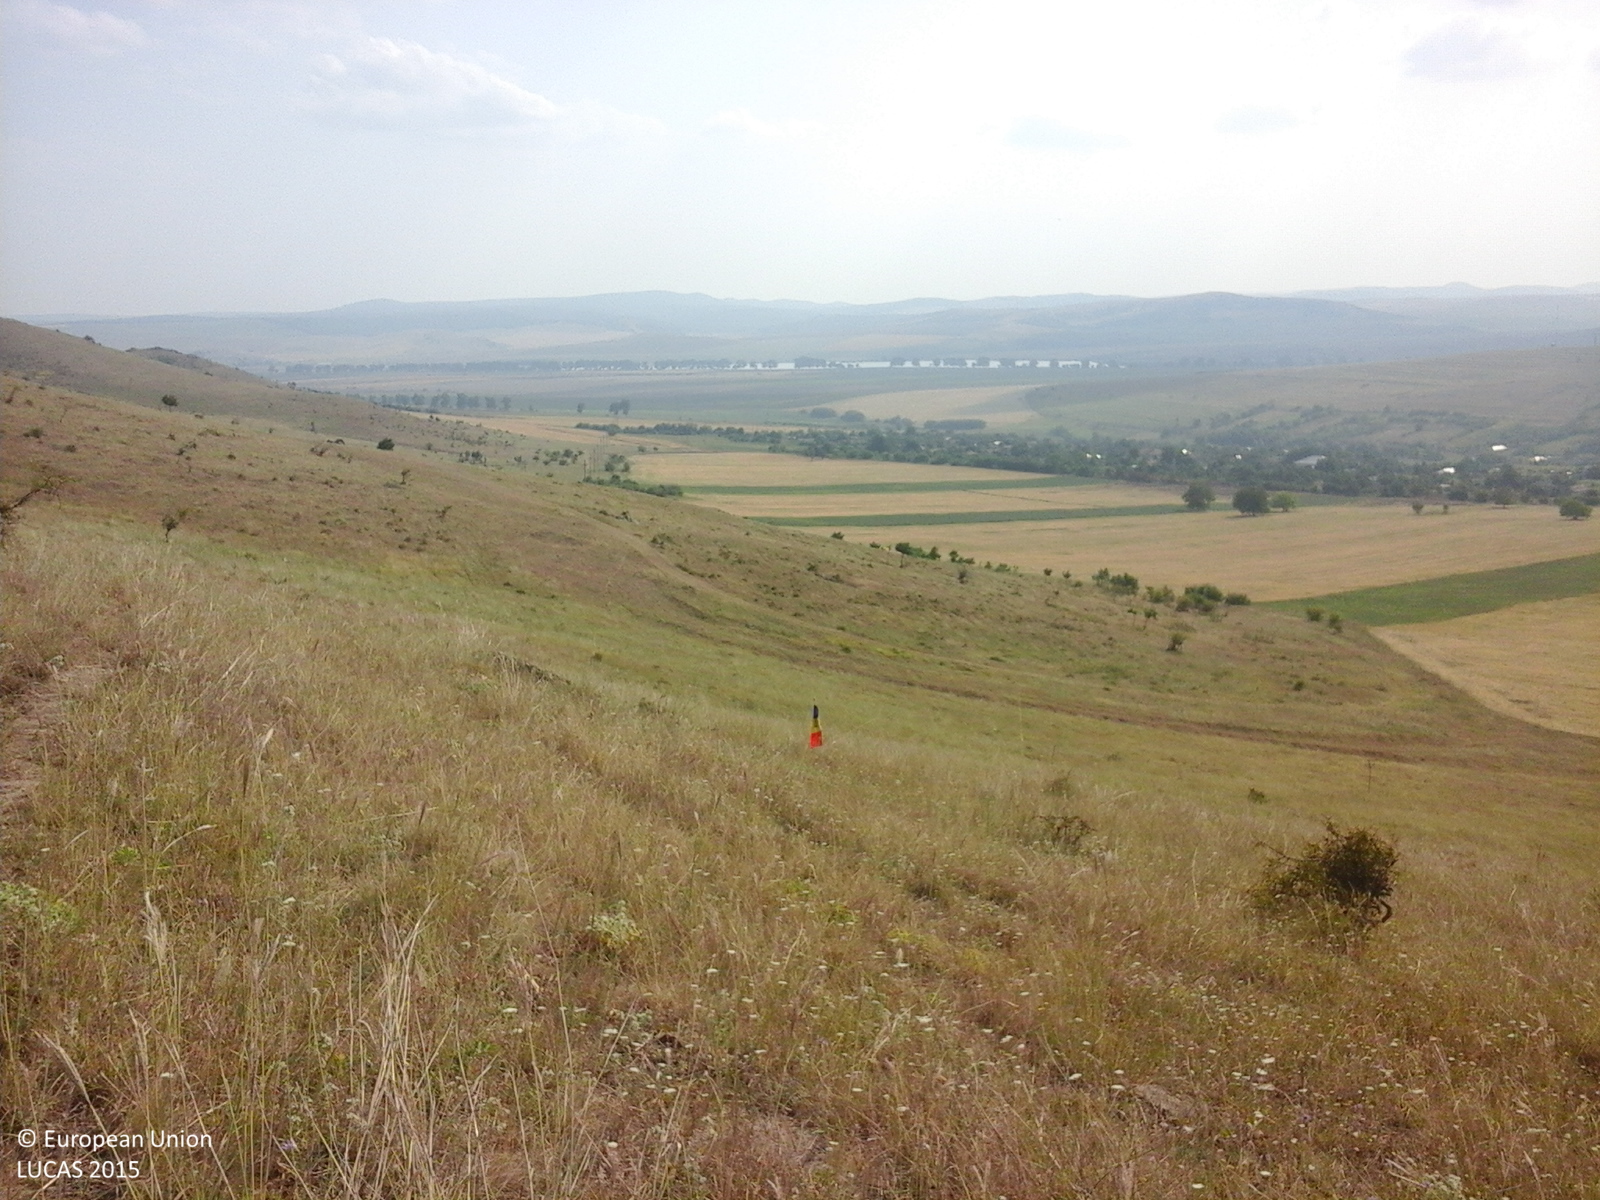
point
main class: Grassland
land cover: Grassland without tree/shrub cover
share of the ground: > 75 %
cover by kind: herbaceous plants 100 %
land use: Agriculture (excluding fallow land and kitchen gardens)
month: July
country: RO
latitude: 45.0772
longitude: 28.4586
